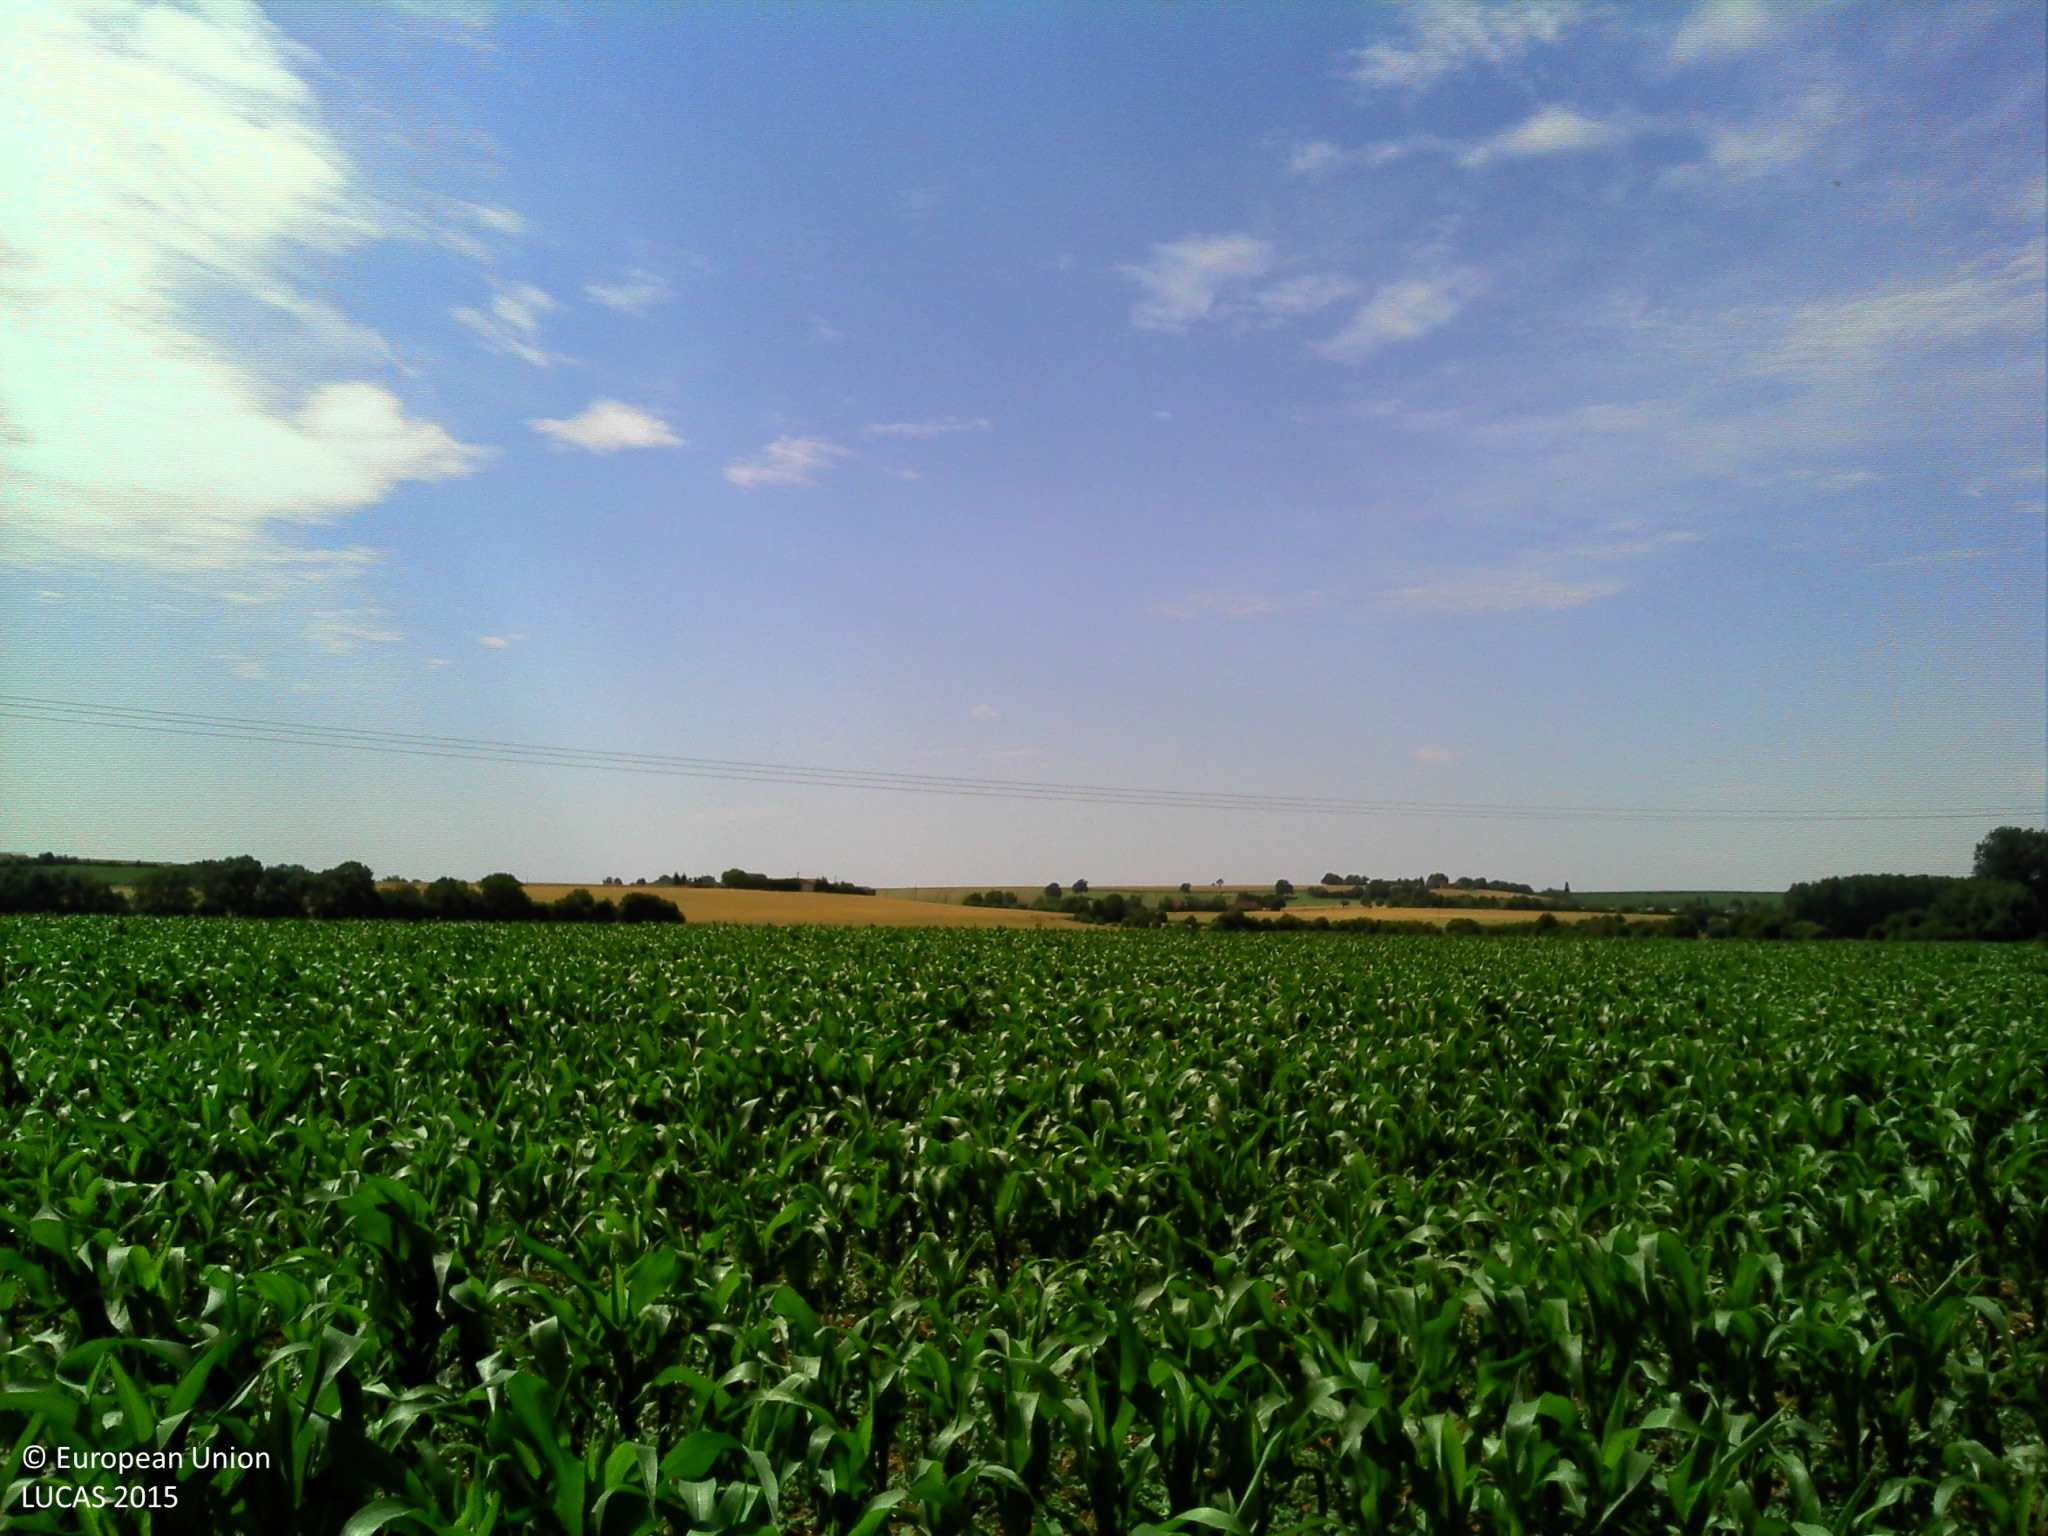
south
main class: Cropland
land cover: Maize
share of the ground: > 75 %
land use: Agriculture (excluding fallow land and kitchen gardens)
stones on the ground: 10 - 25 %
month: June
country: FR
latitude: 48.3160
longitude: 0.2507
